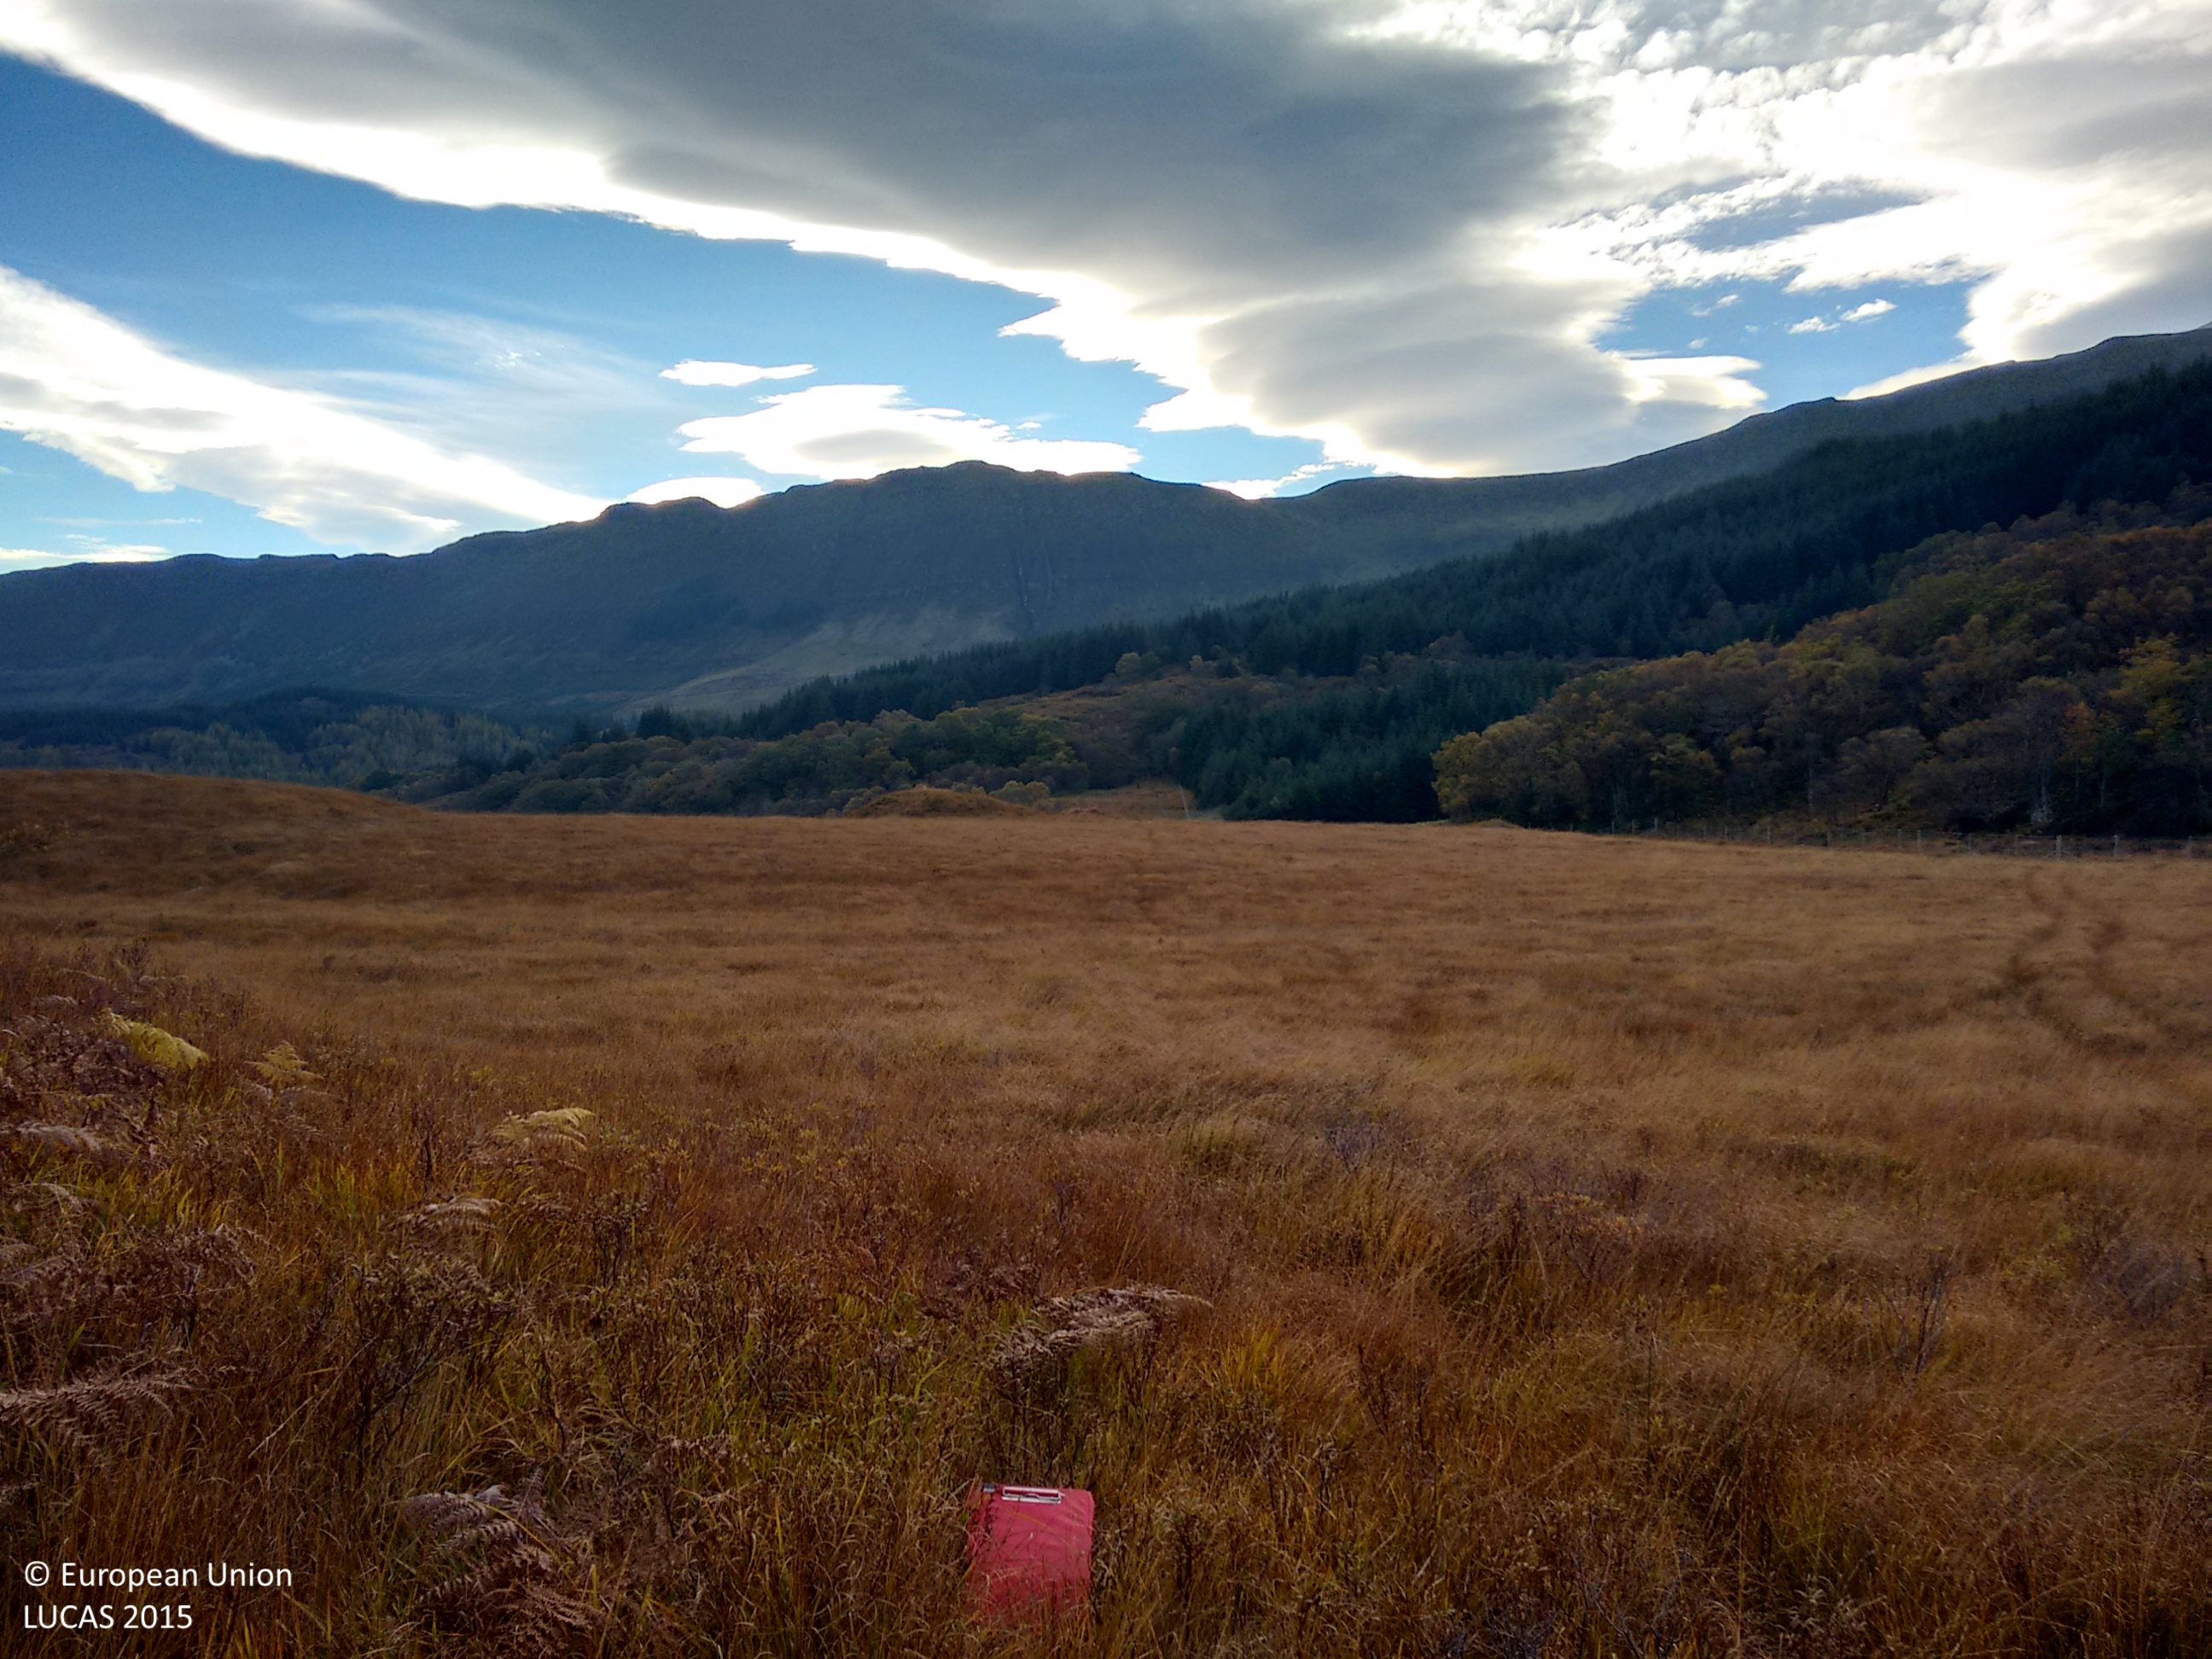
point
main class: Shrubland
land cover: Shrubland without tree cover
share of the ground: > 75 %
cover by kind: herbaceous plants 60 %, shrubs 40 %
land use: Semi-natural and natural areas not in use
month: October
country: GB
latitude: 56.6118
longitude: -5.8185
